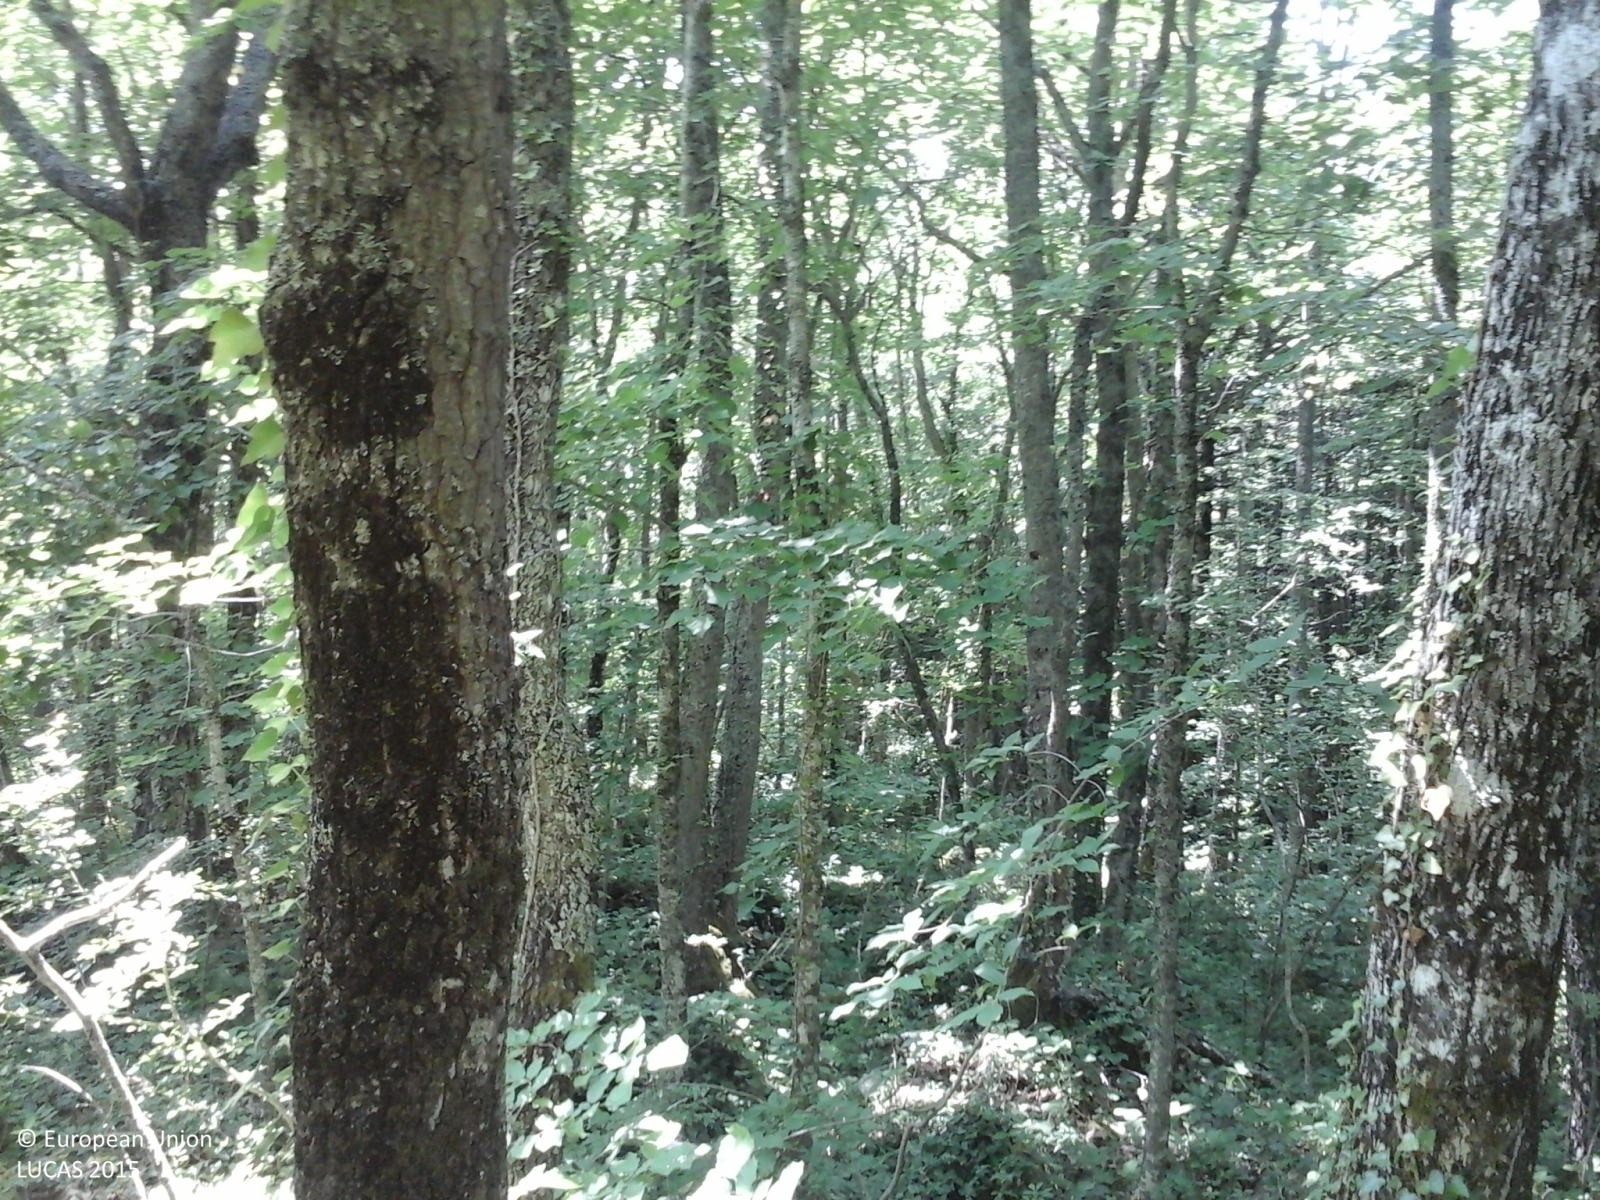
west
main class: Woodland
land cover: Other mixed woodland
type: hemiboreal forest and nemoral coniferous forest and mixed broadleaved-coniferous forest
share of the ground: > 75 %
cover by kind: coniferous forest trees 40 %, broadleaved forest trees 40 %, shrubs 10 %, herbaceous plants 5 %, lichens and mosses 5 %
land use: Forestry
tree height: > 5 m
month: June
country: IT
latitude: 41.8929
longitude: 14.3125
